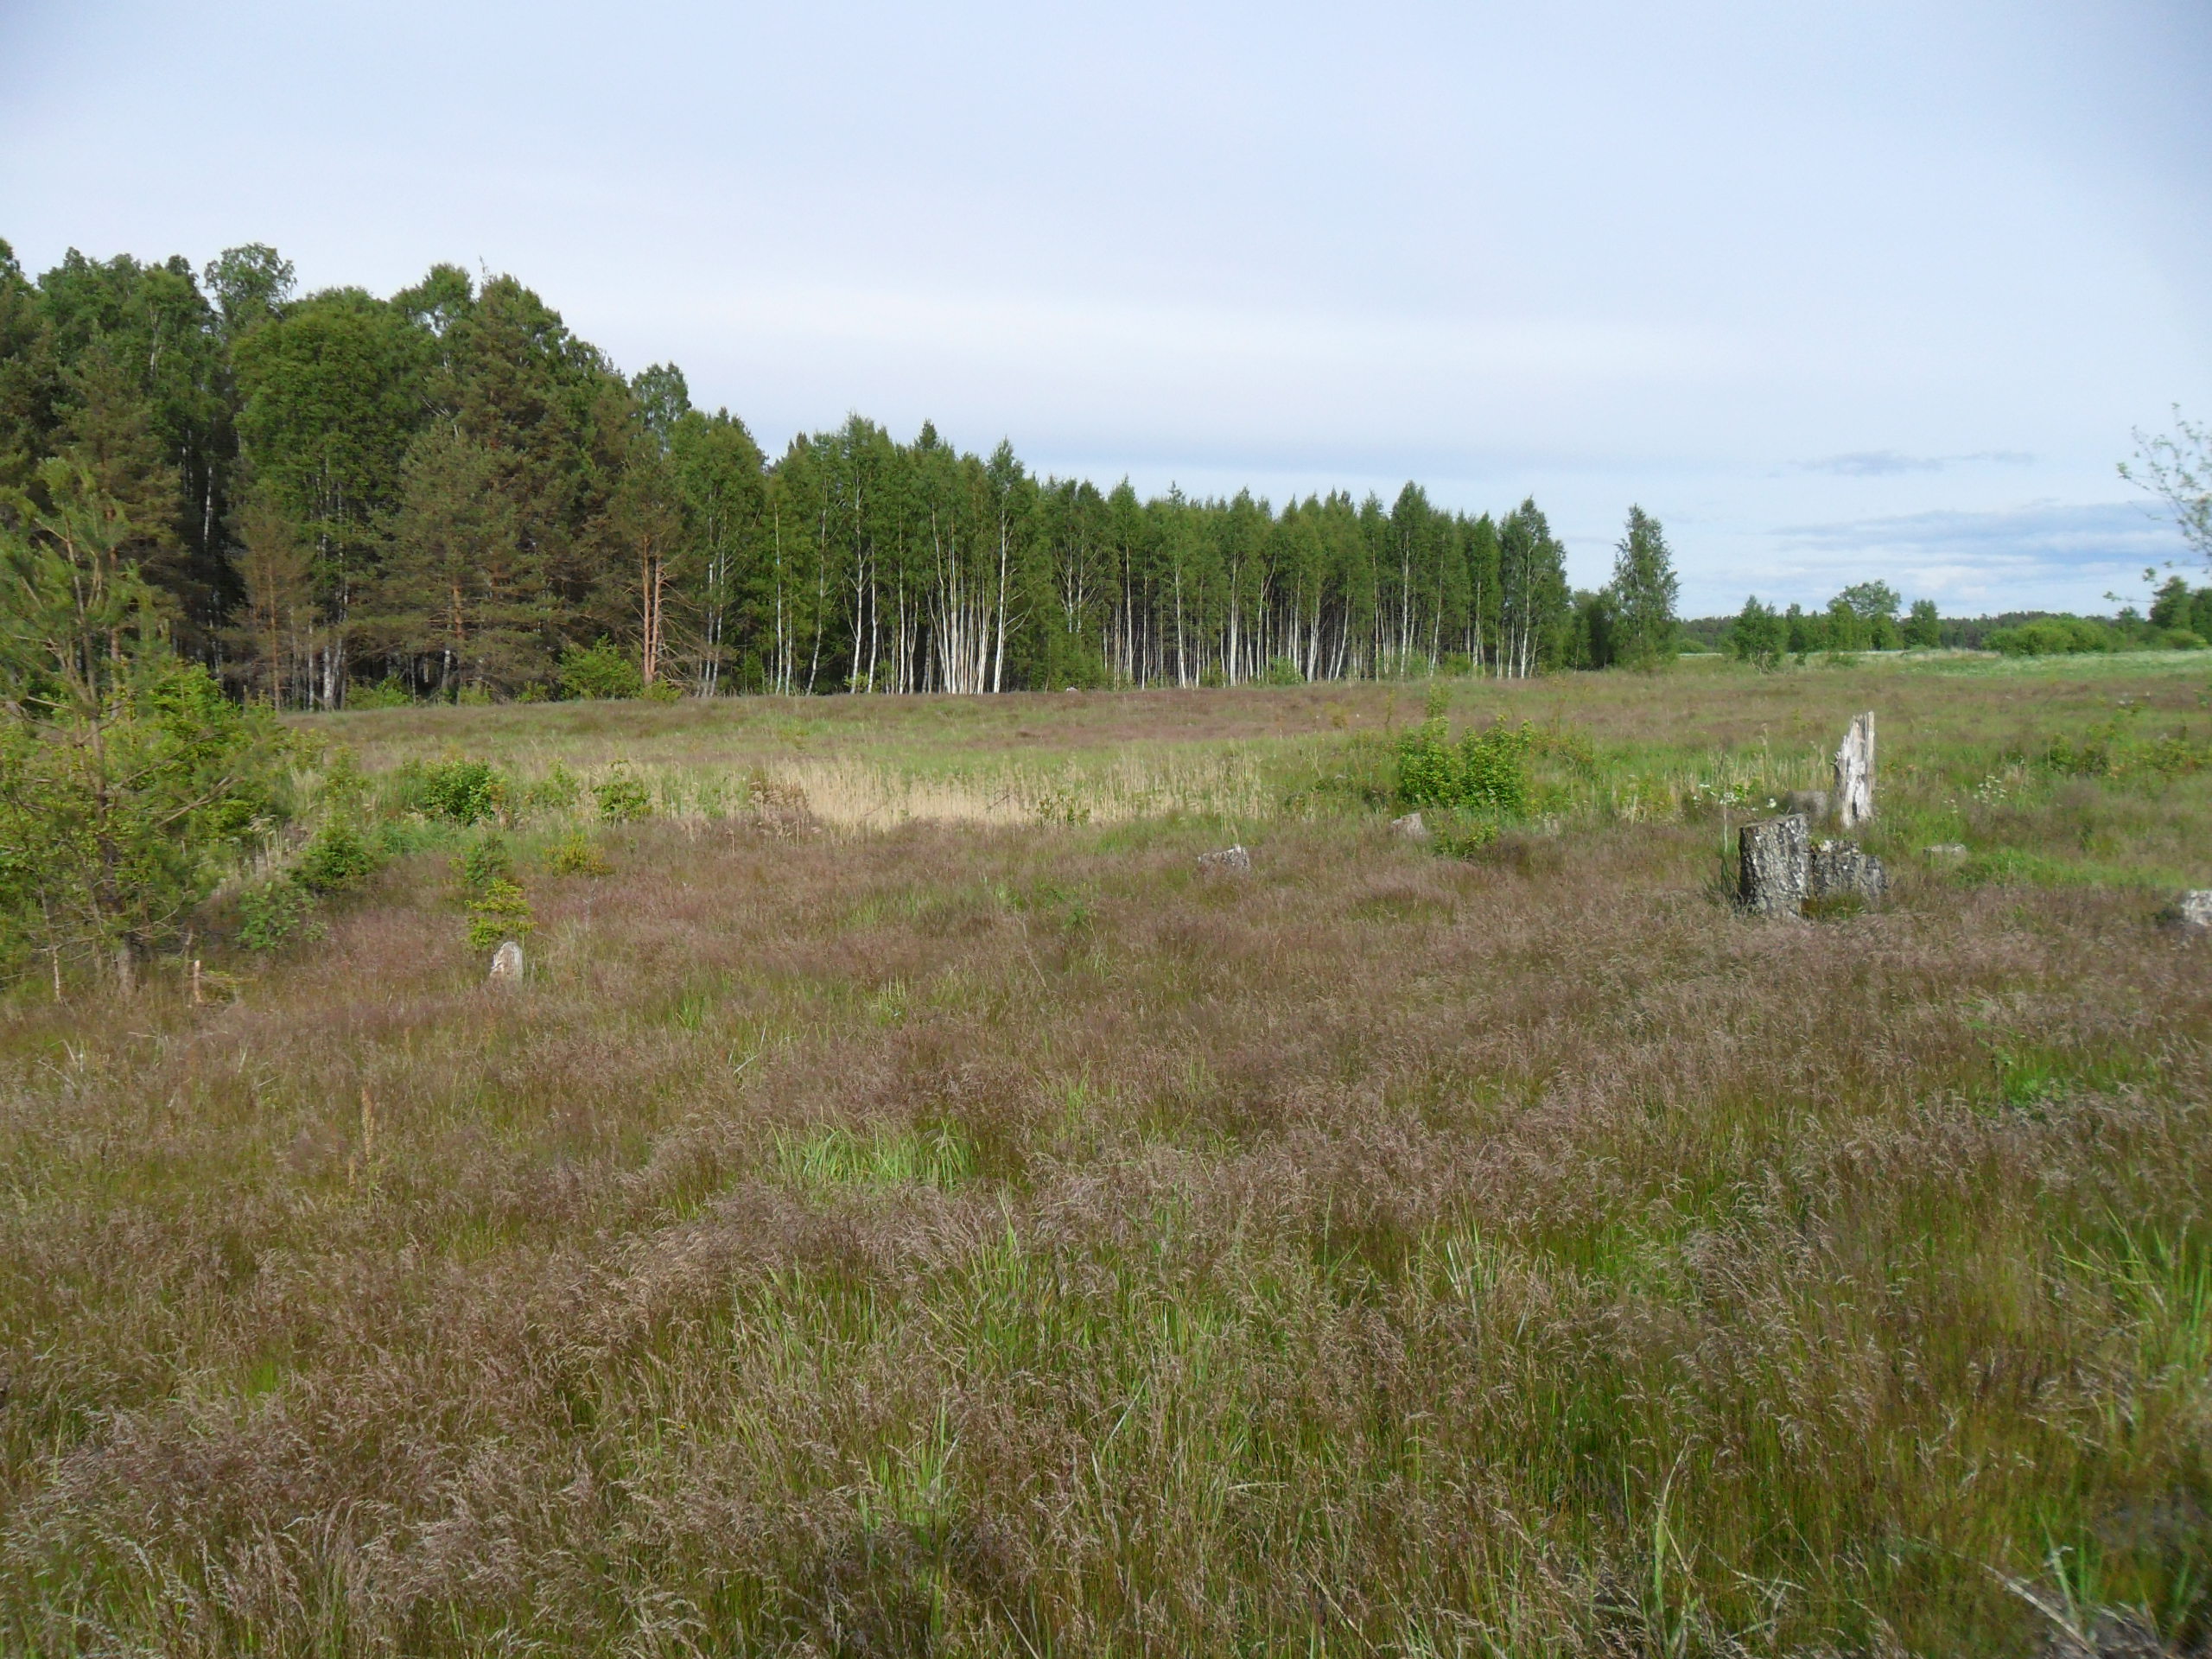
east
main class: Grassland
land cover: Spontaneously vegetated surfaces
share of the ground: > 75 %
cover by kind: herbaceous plants 100 %
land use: Semi-natural and natural areas not in use
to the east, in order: Spontaneously vegetated surfaces; Ditches and canals; Spontaneously vegetated surfaces; Shruby margins; Rivers and streams; Shruby margins; Spontaneously vegetated surfaces
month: June
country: LV
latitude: 57.6271
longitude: 22.5620
